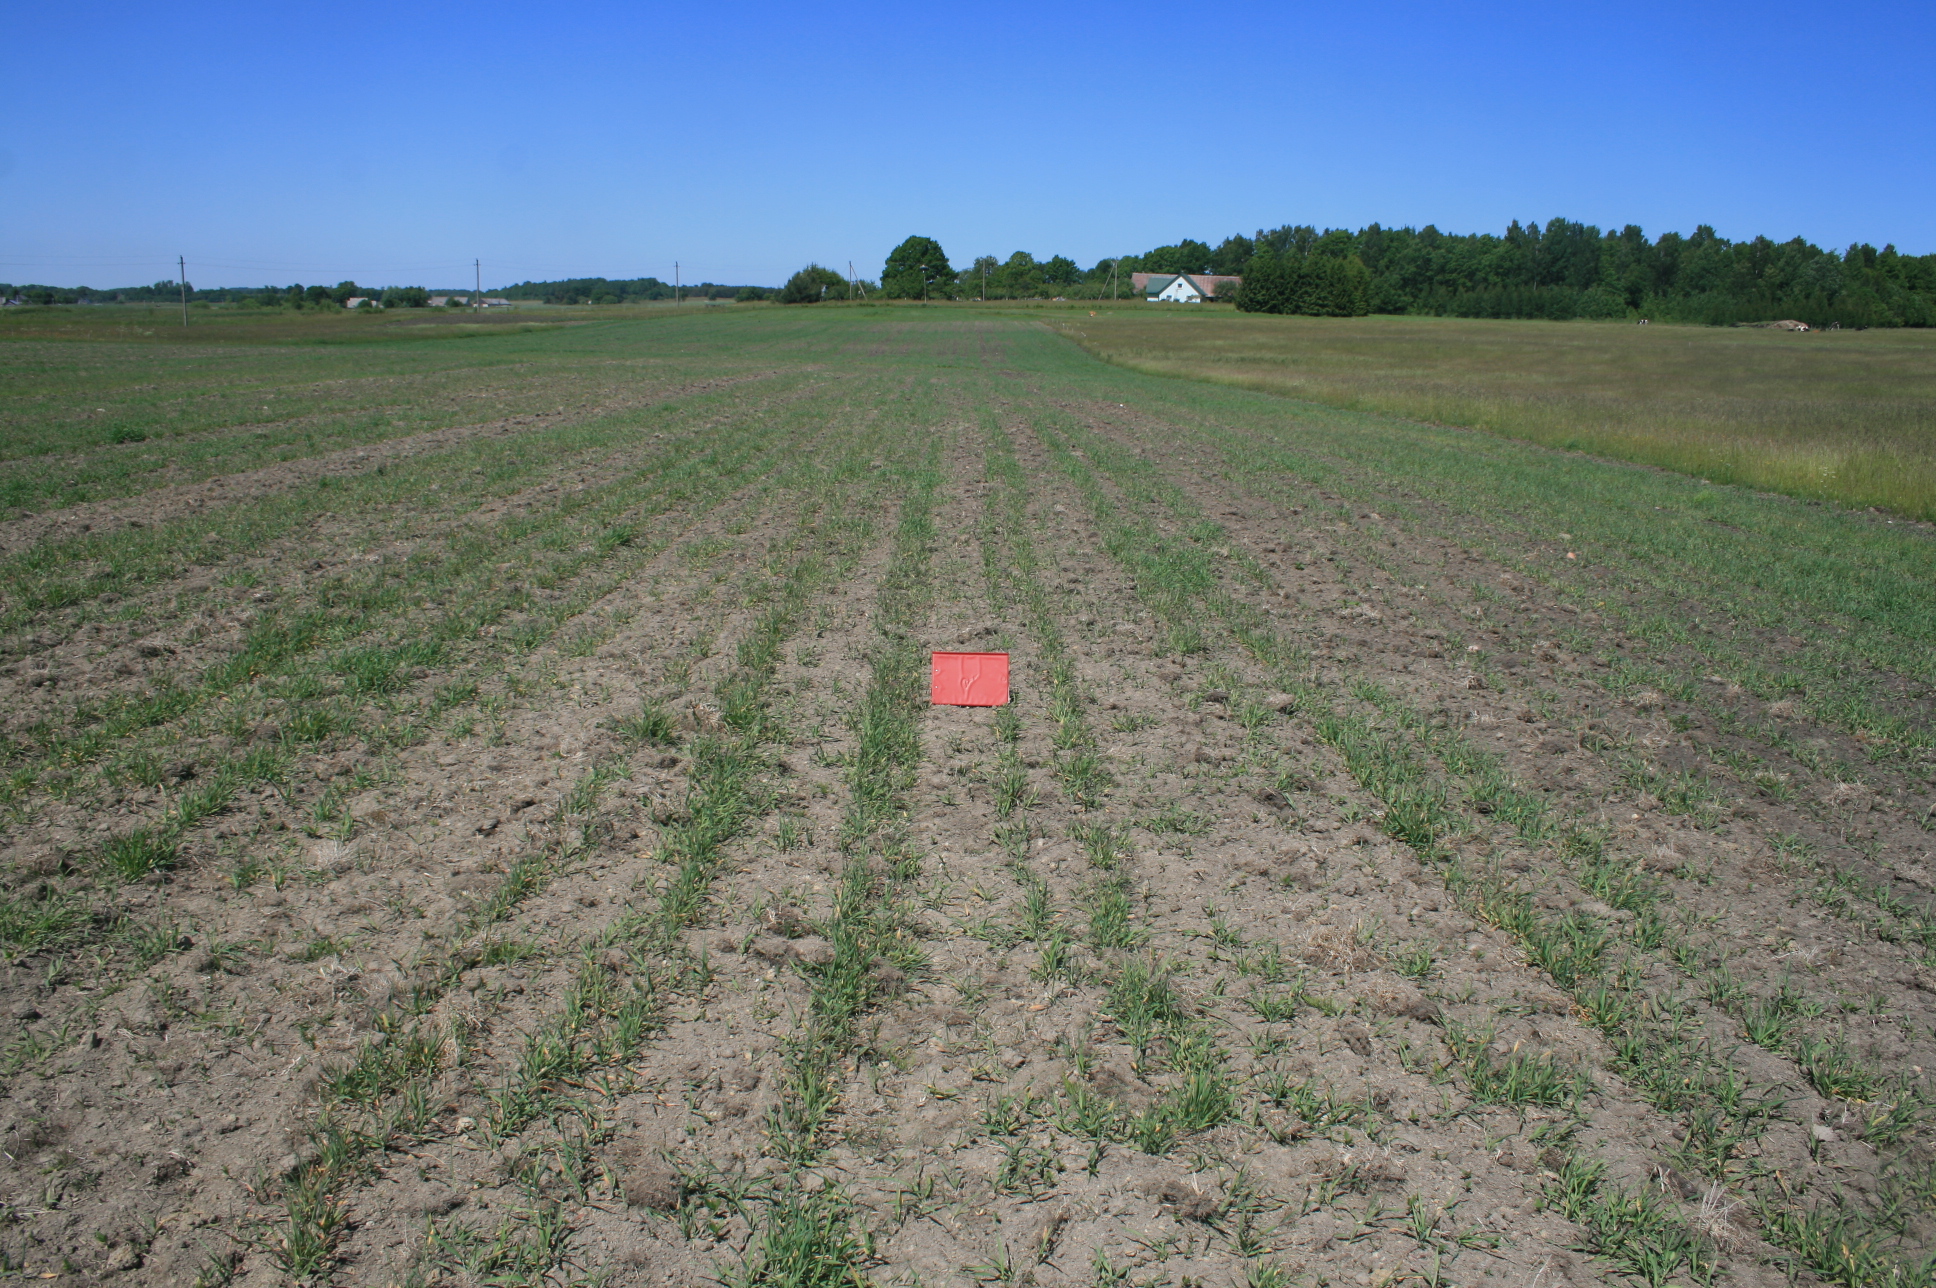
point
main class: Cropland
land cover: Barley
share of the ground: 25 - 50 %
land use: Agriculture (excluding fallow land and kitchen gardens)
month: June
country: LT
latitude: 55.5325
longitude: 22.1761
